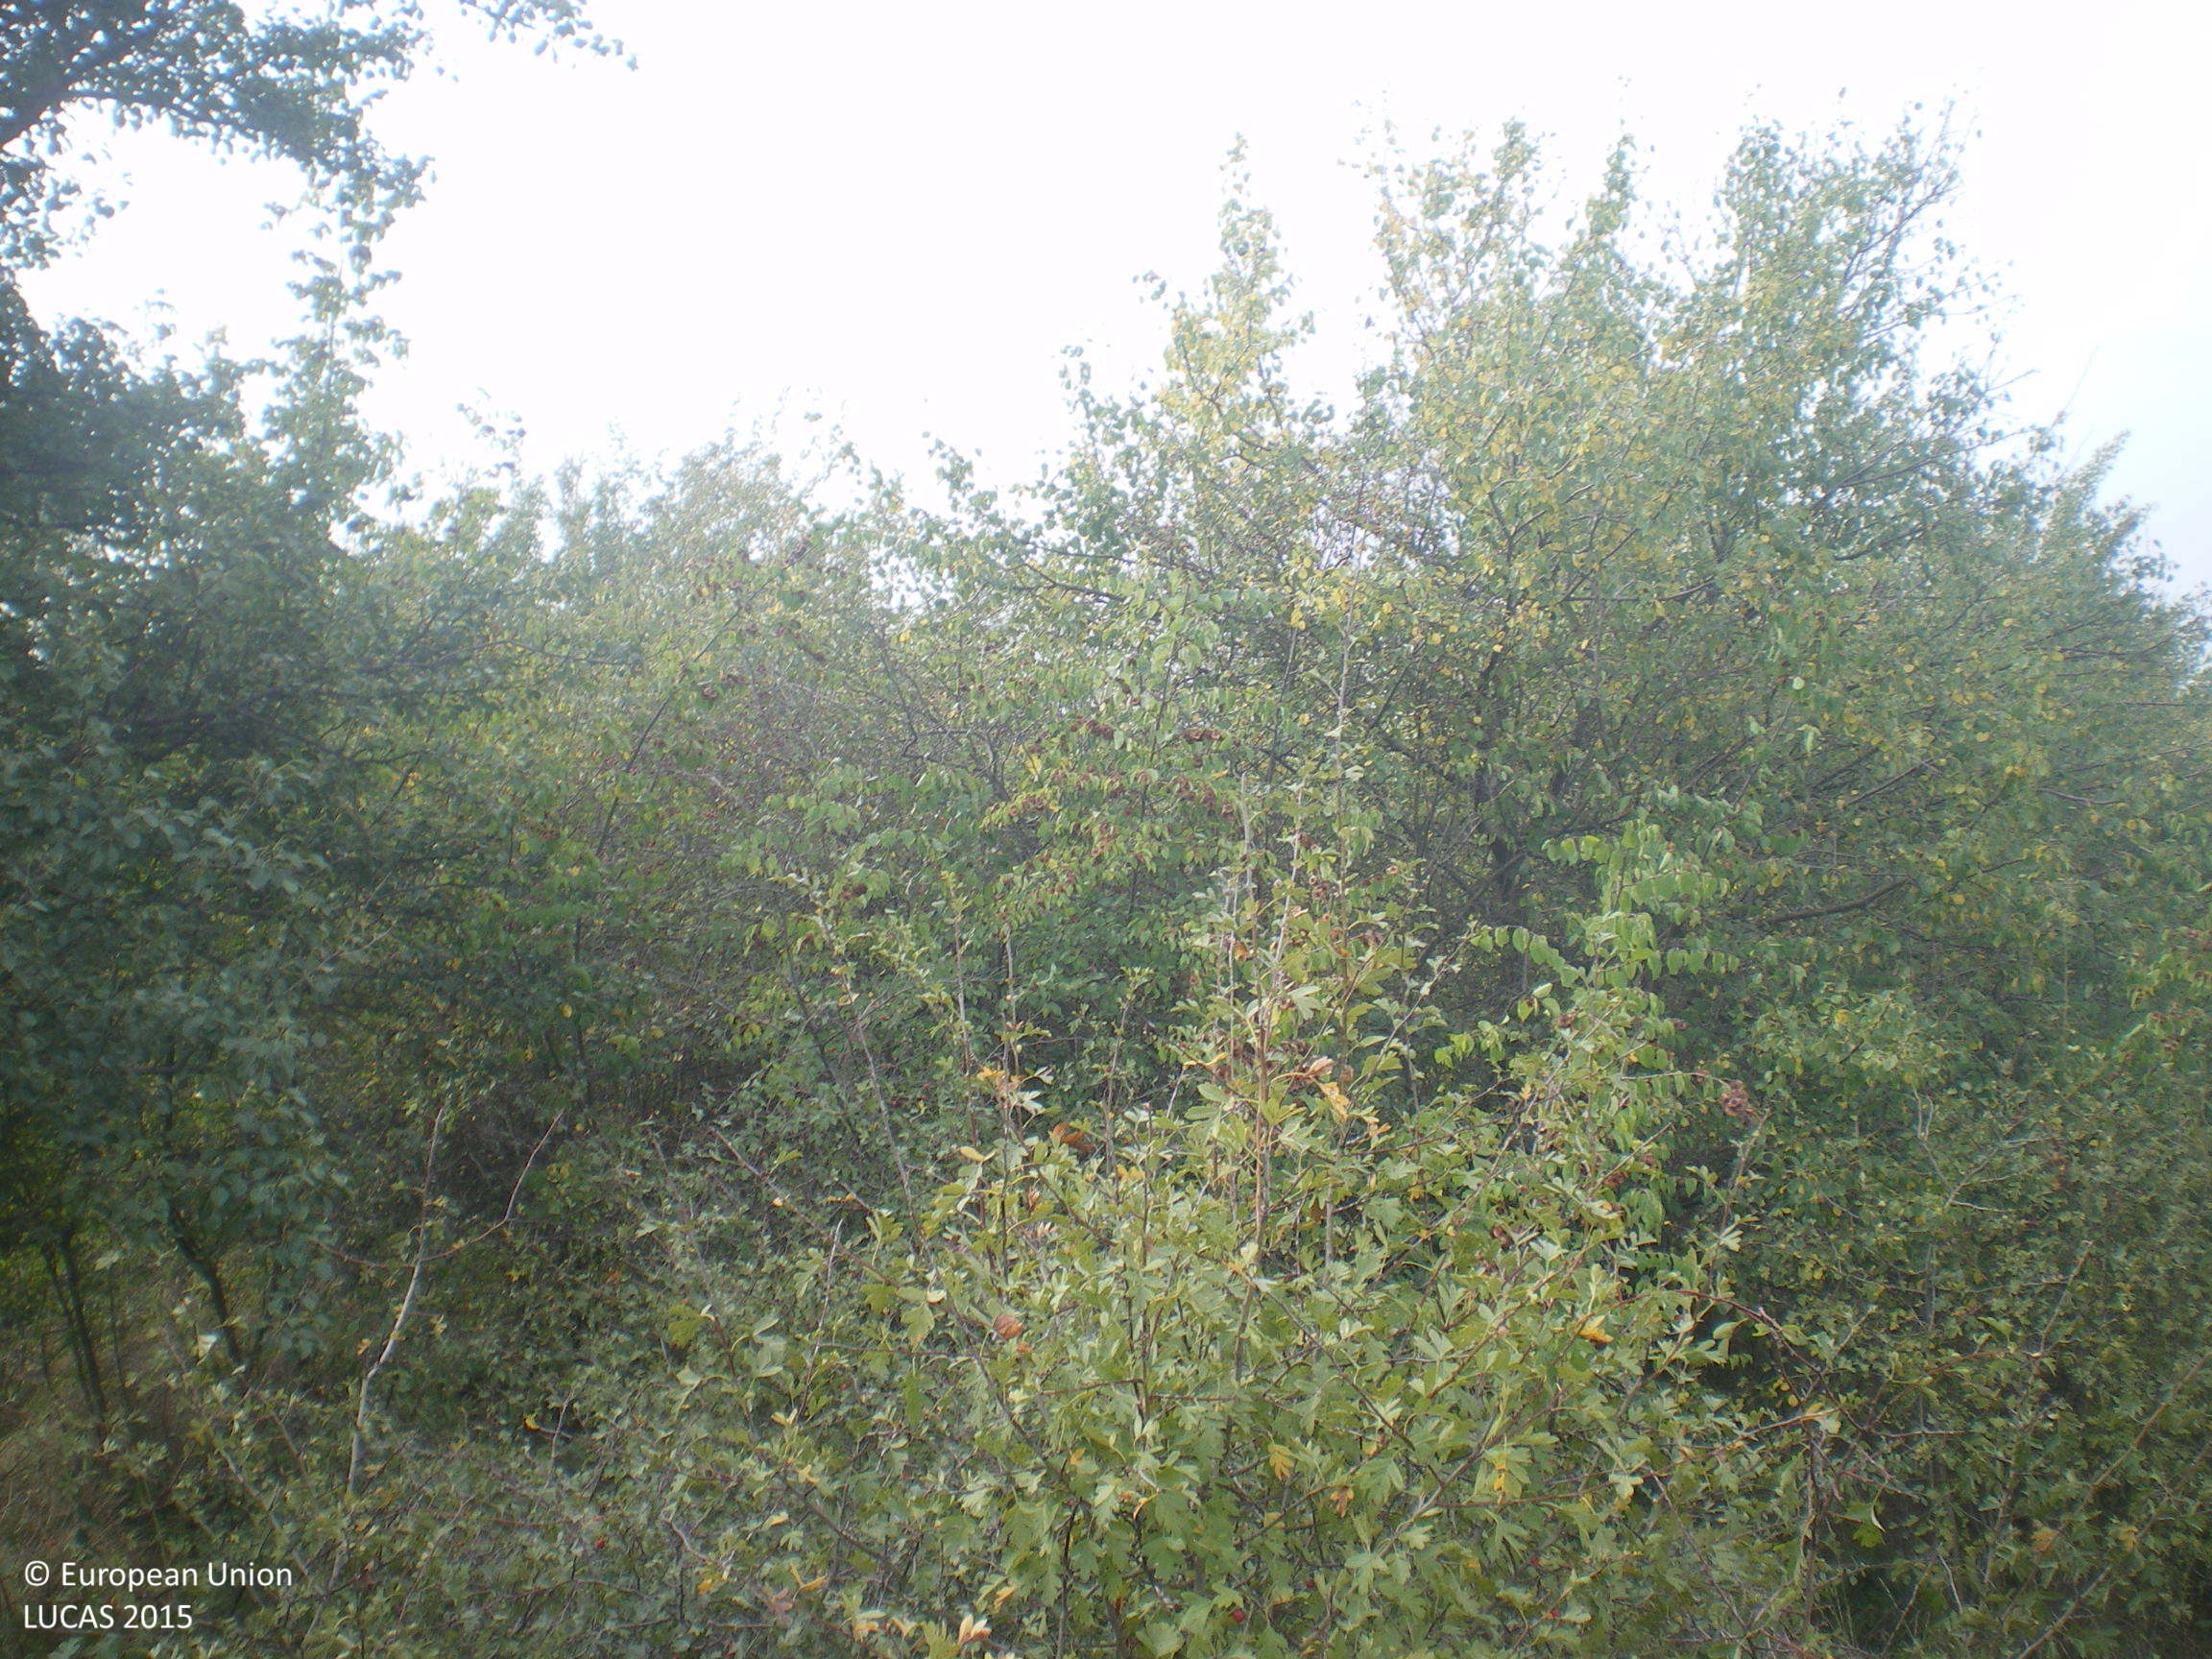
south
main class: Grassland
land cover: Grassland with sparse tree/shrub cover
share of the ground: > 75 %
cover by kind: herbaceous plants 90 %, broadleaved forest trees 5 %, shrubs 5 %
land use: Agriculture (excluding fallow land and kitchen gardens)
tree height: > 5 m
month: September
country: BG
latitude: 42.1009
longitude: 25.9267
